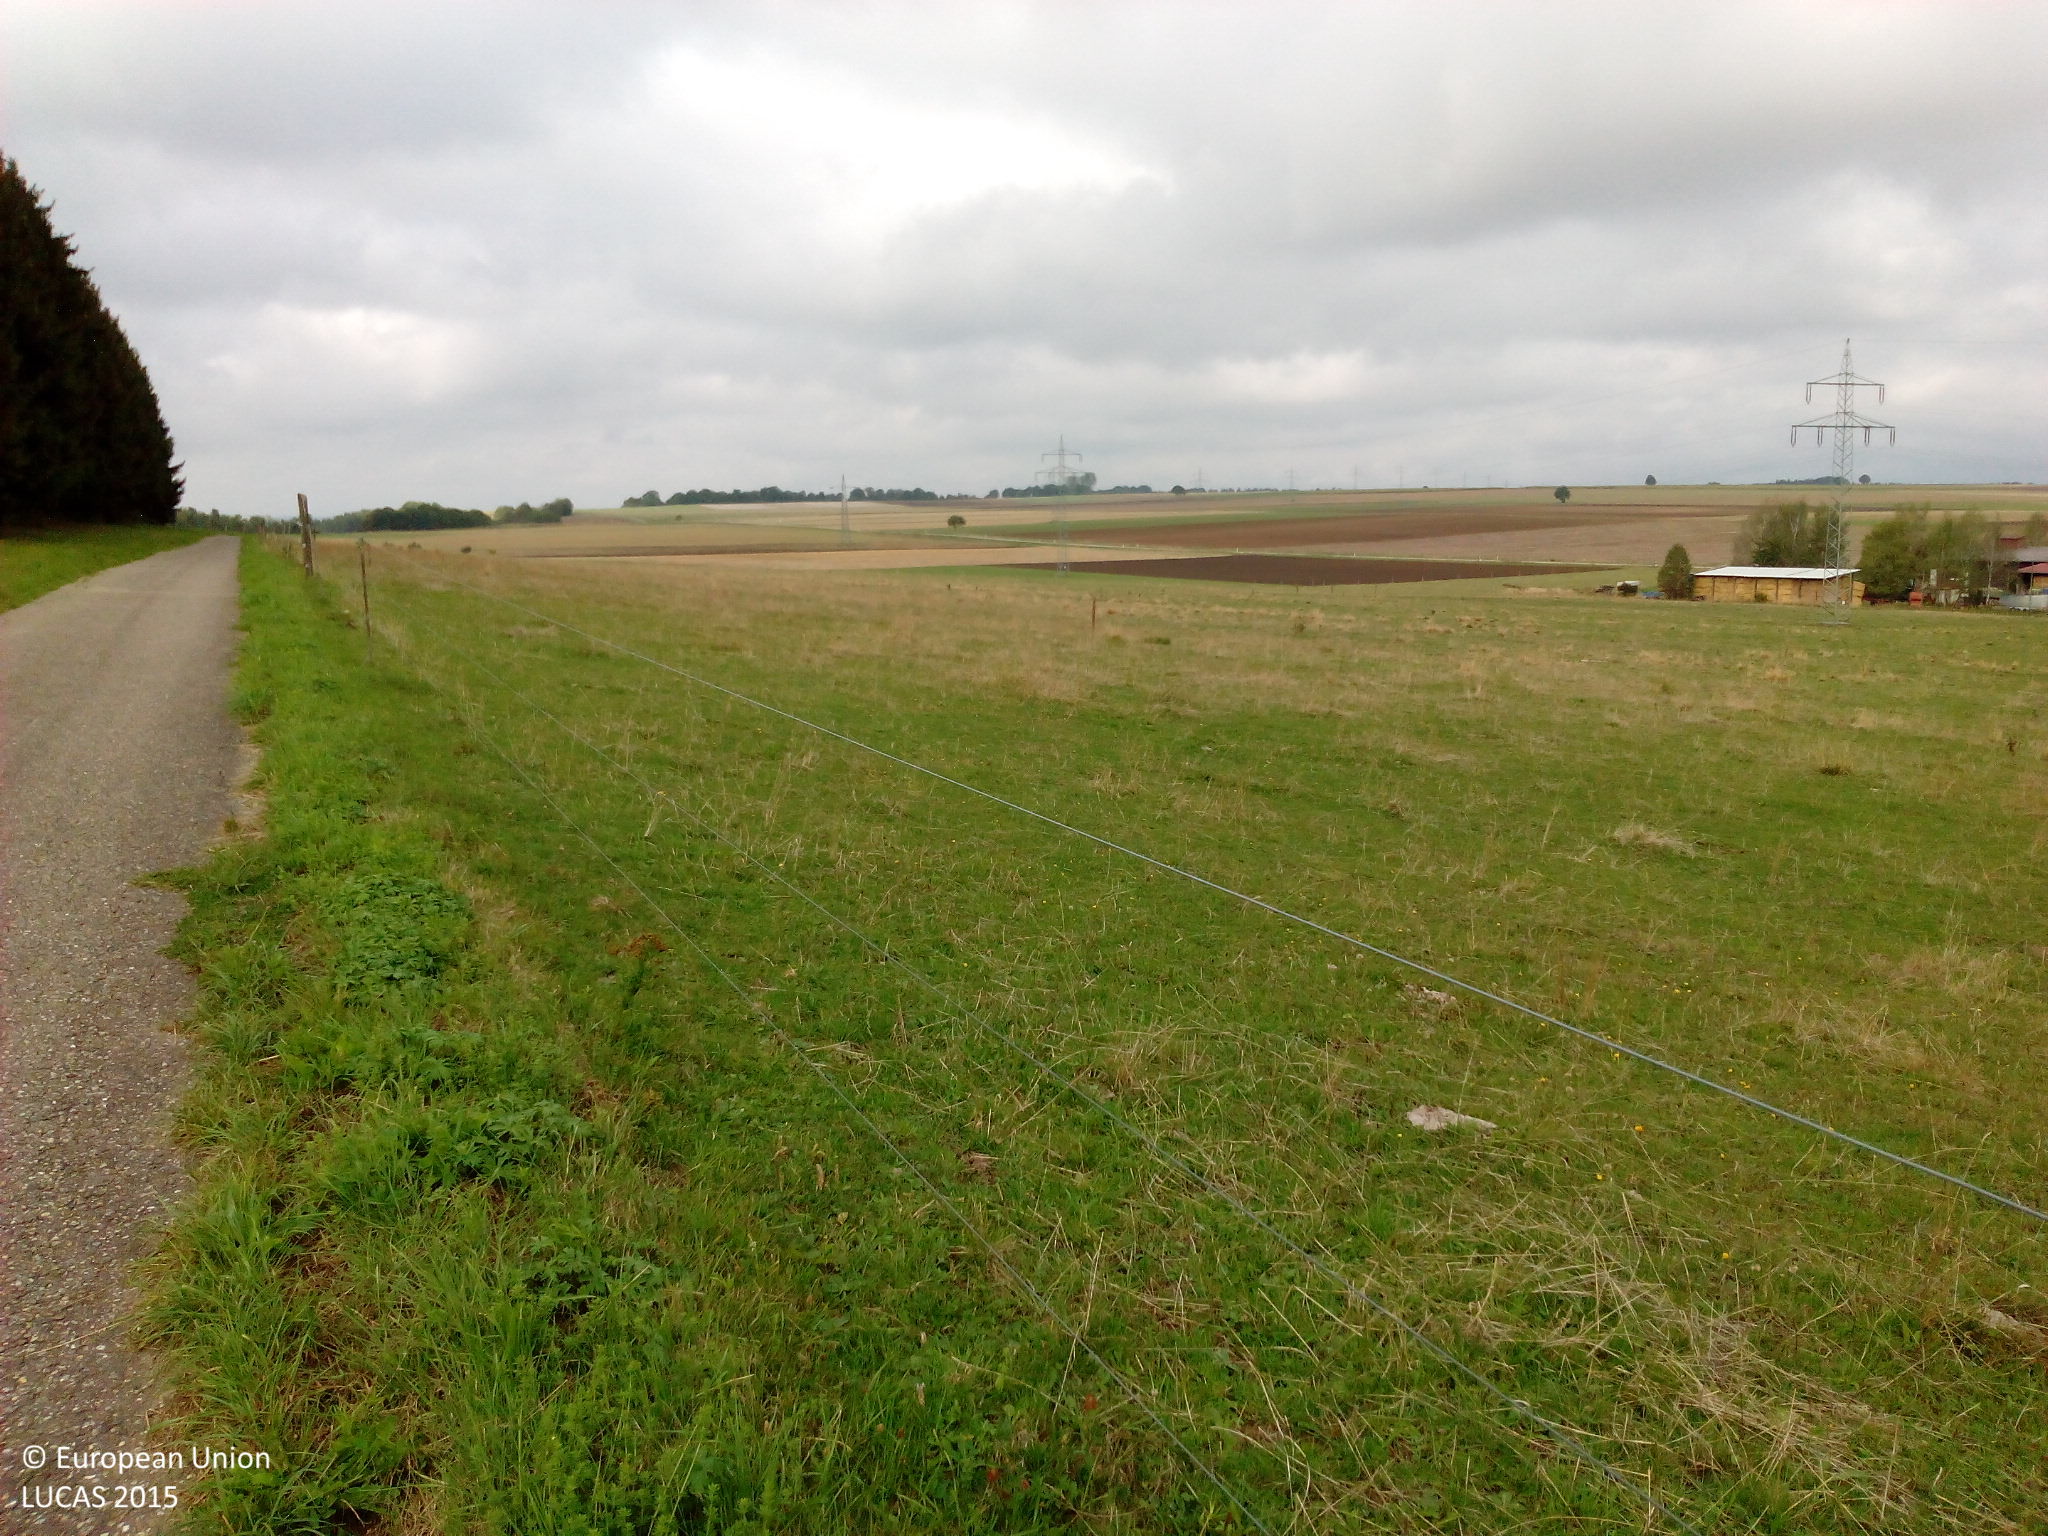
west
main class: Grassland
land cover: Grassland without tree/shrub cover
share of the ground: > 75 %
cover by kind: herbaceous plants 95 %, unconsolidated bare surface 5 %
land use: Agriculture (excluding fallow land and kitchen gardens)
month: September
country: DE
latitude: 48.2341
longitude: 8.7217
